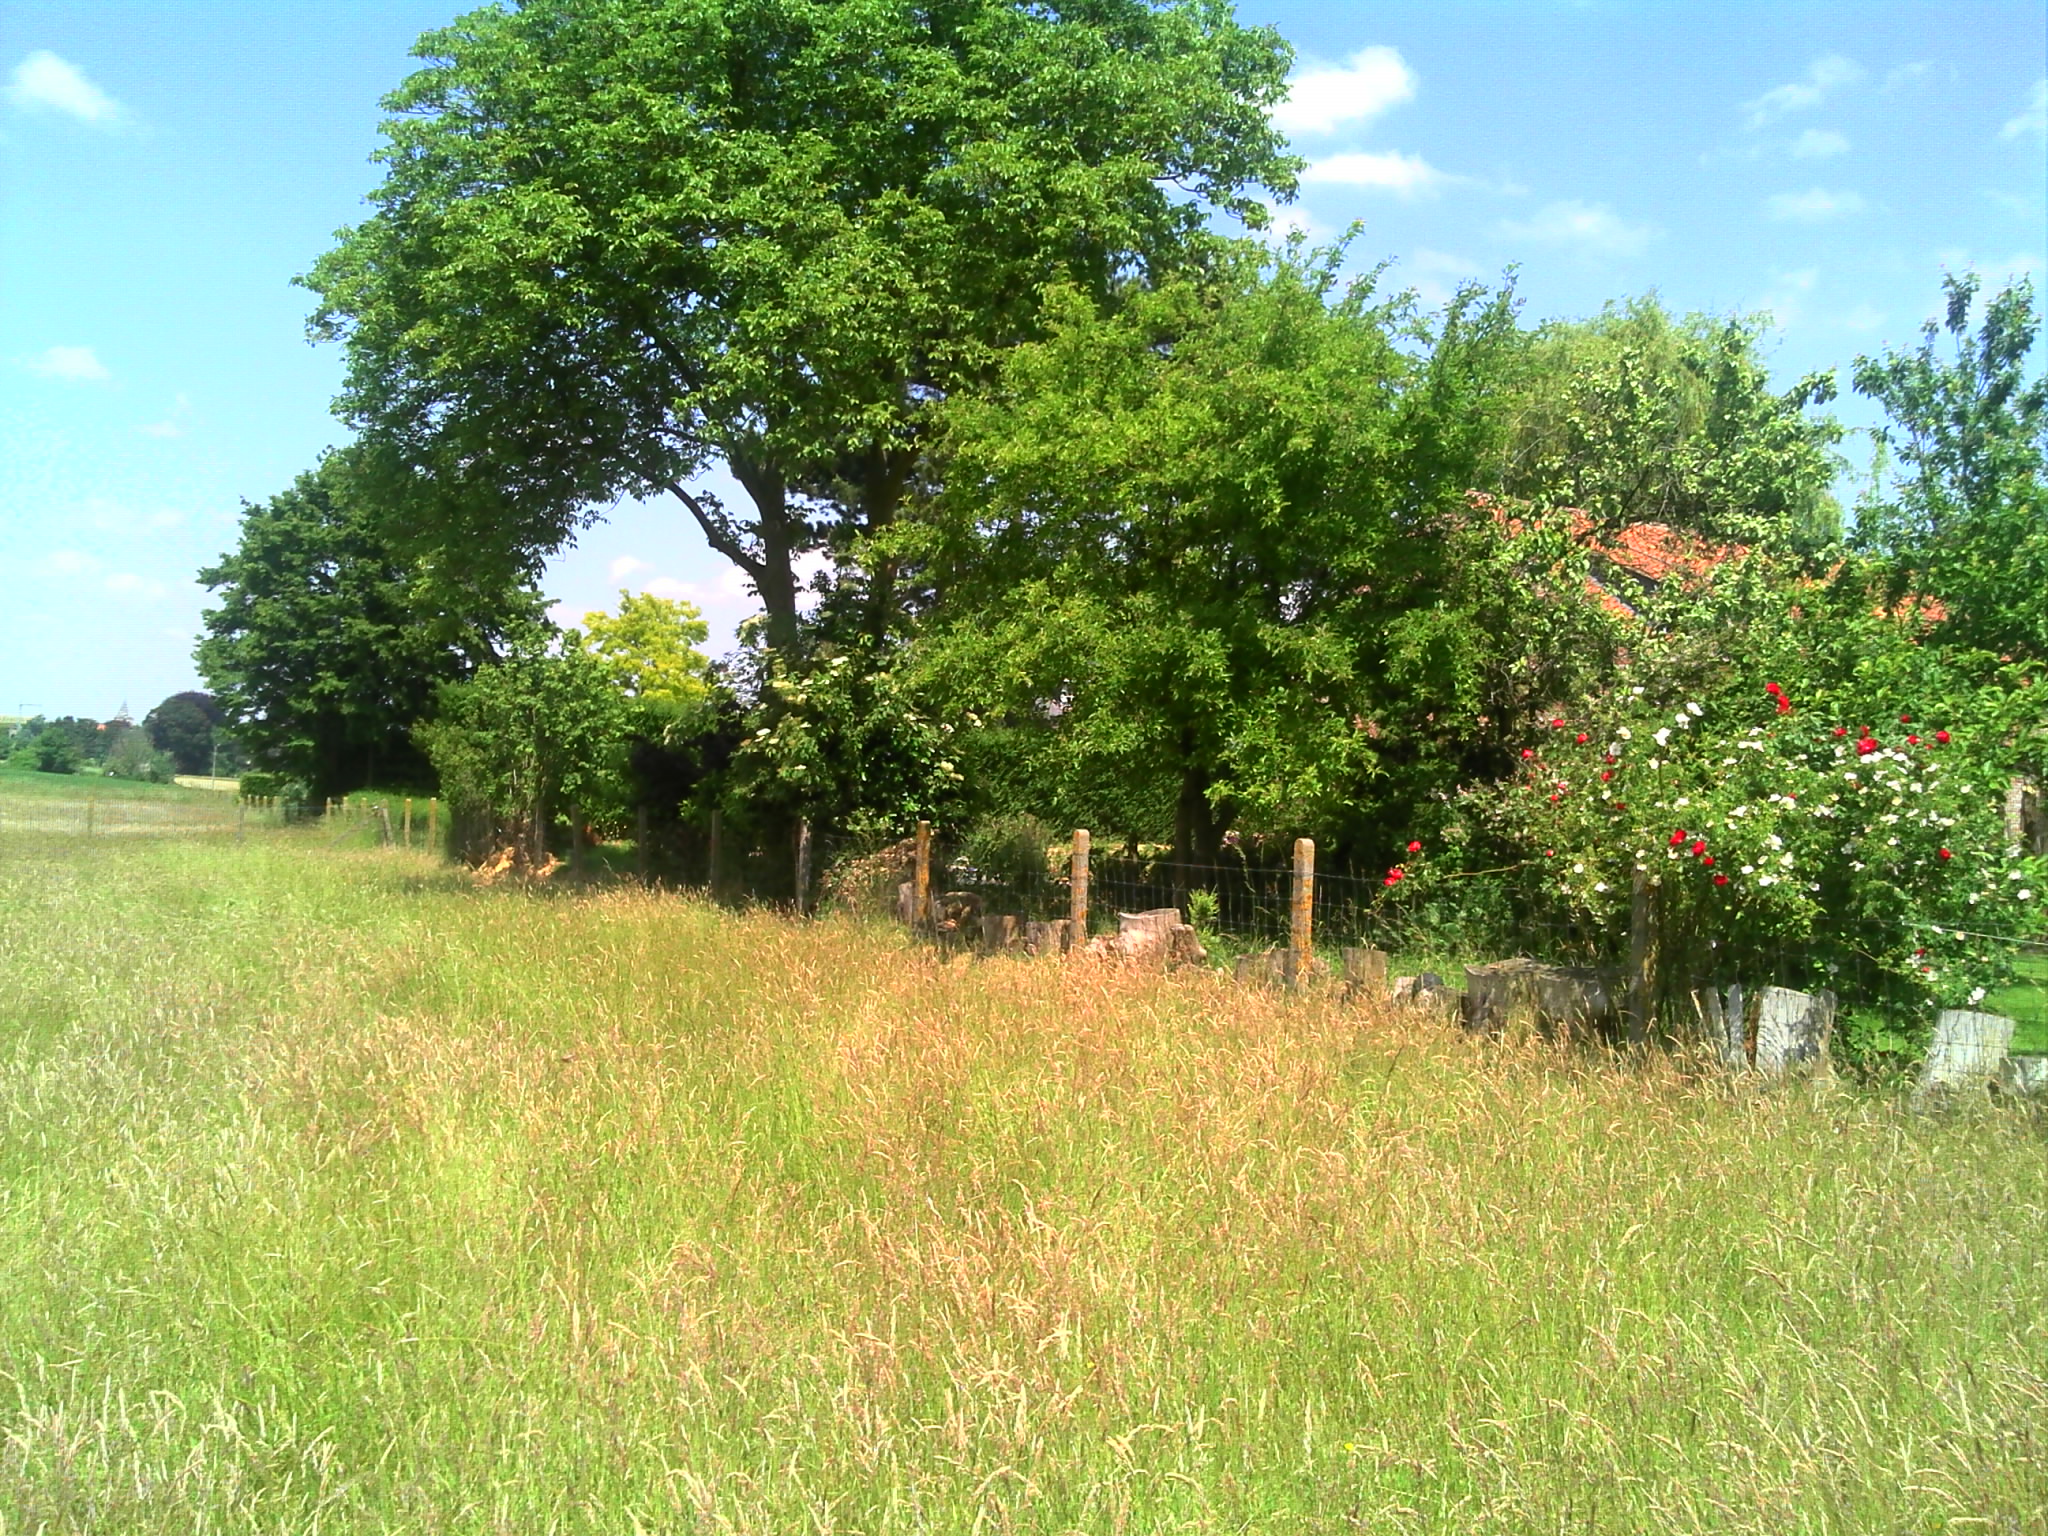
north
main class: Grassland
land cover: Grassland without tree/shrub cover
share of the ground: > 75 %
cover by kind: herbaceous plants 100 %
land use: Agriculture (excluding fallow land and kitchen gardens)
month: June
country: BE
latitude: 50.9438
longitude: 4.3164
